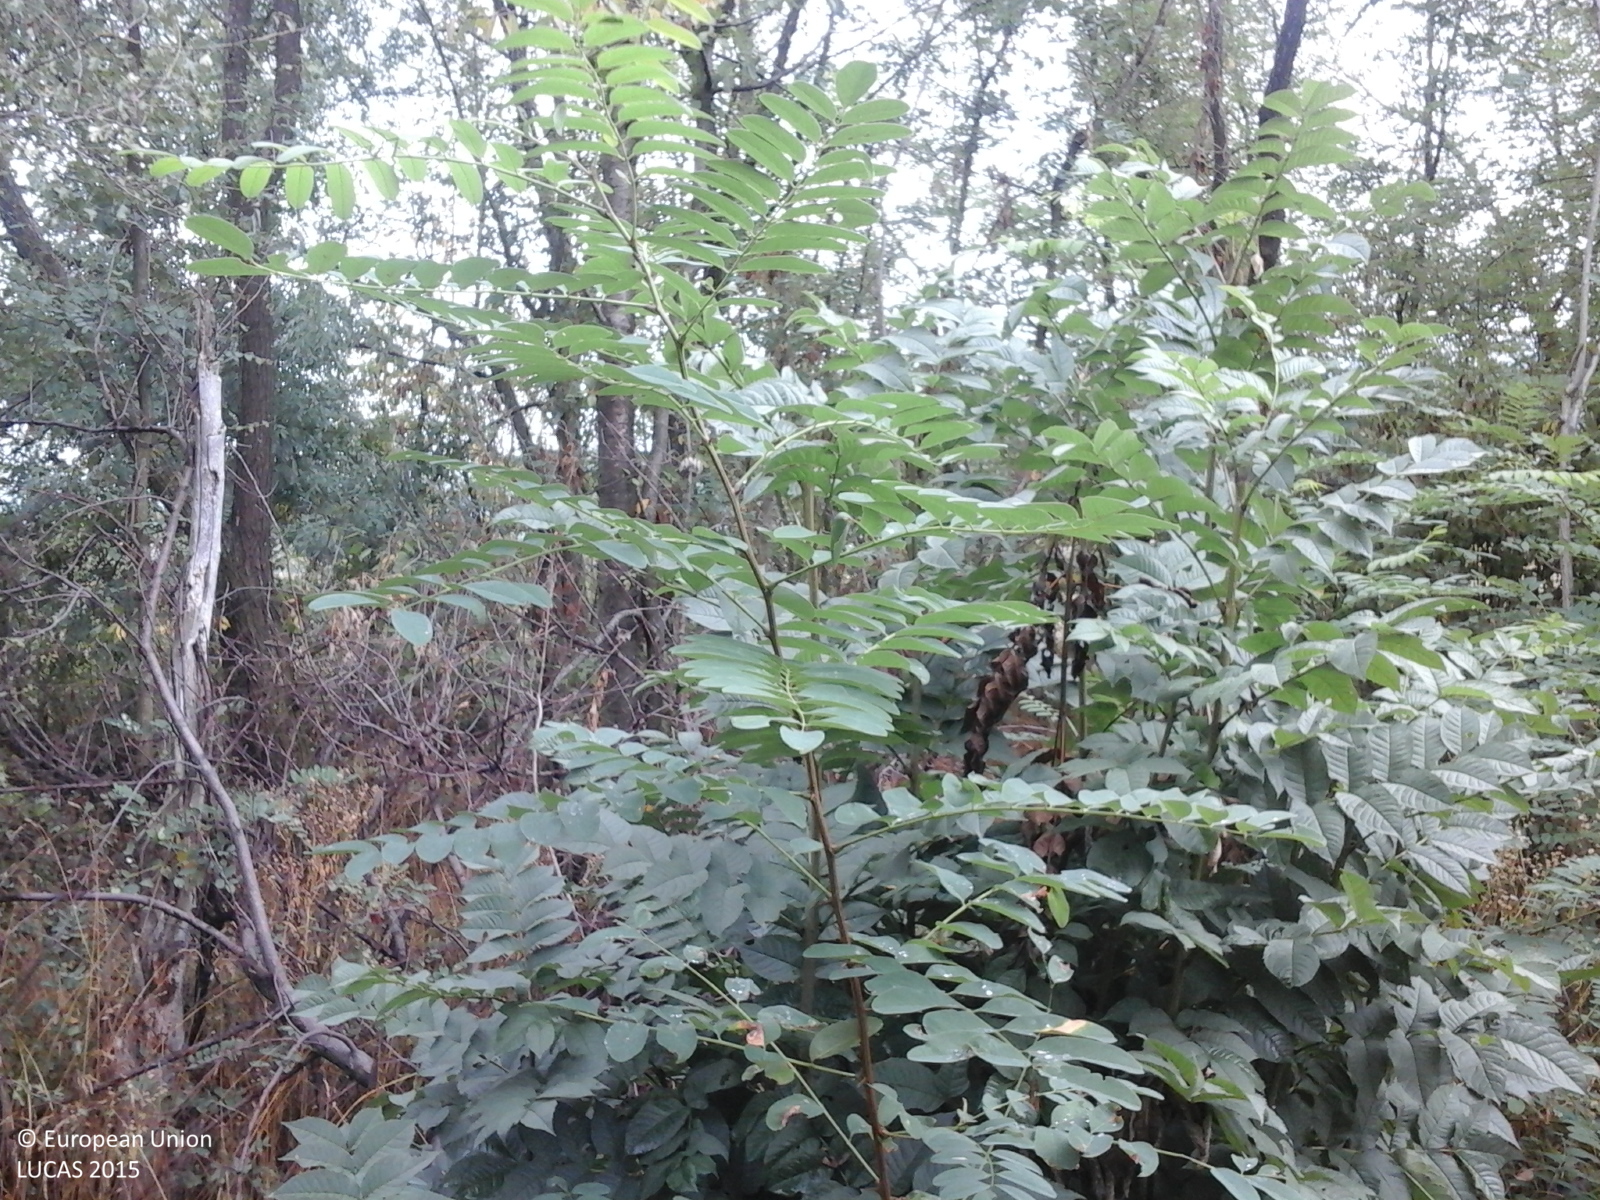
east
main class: Woodland
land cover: Broadleaved woodland
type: exotic forest
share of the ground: > 75 %
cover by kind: broadleaved forest trees 100 %
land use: Forestry
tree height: > 5 m
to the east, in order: Broadleaved woodland; Grassland without tree/shrub cover; Shrubland with sparse tree cover
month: August
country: RO
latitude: 44.8962
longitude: 22.1038
